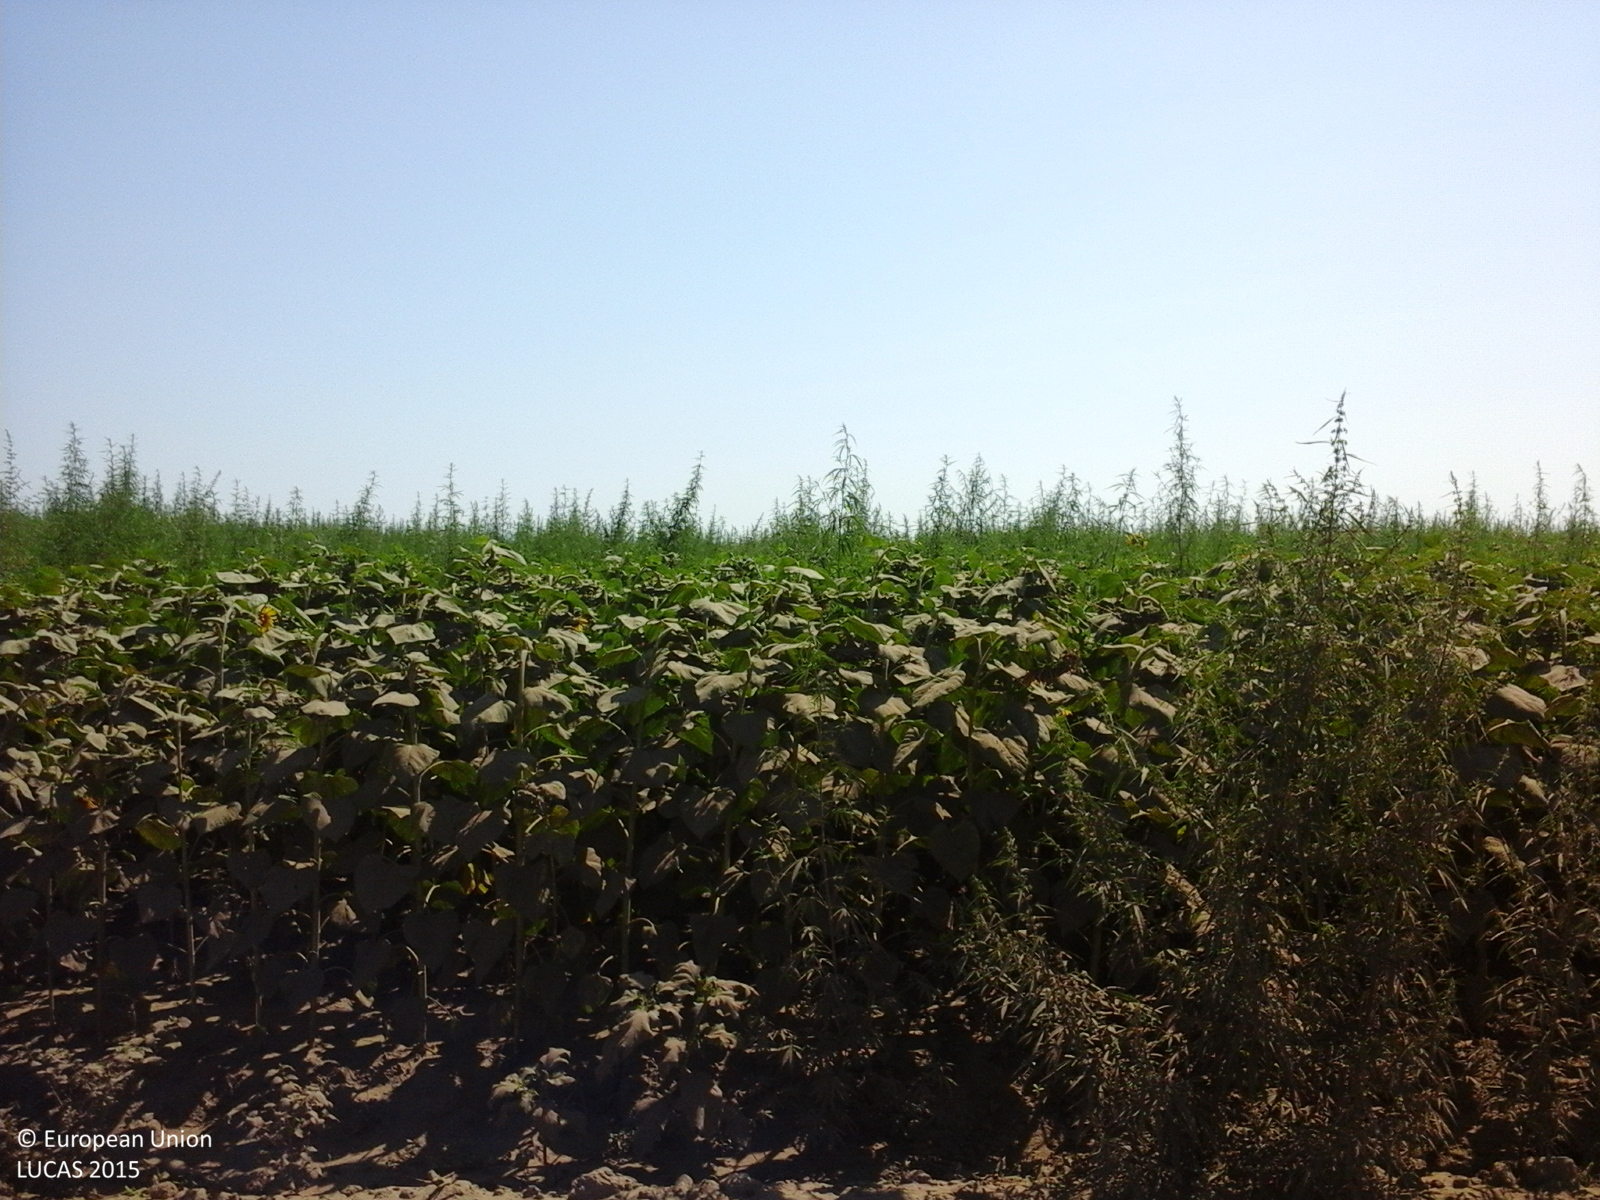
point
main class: Cropland
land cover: Sunflower
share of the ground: > 75 %
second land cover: Other fibre and oleaginous crops
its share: 50 - 75 %
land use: Agriculture (excluding fallow land and kitchen gardens)
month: July
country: RO
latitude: 44.2651
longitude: 27.5153
